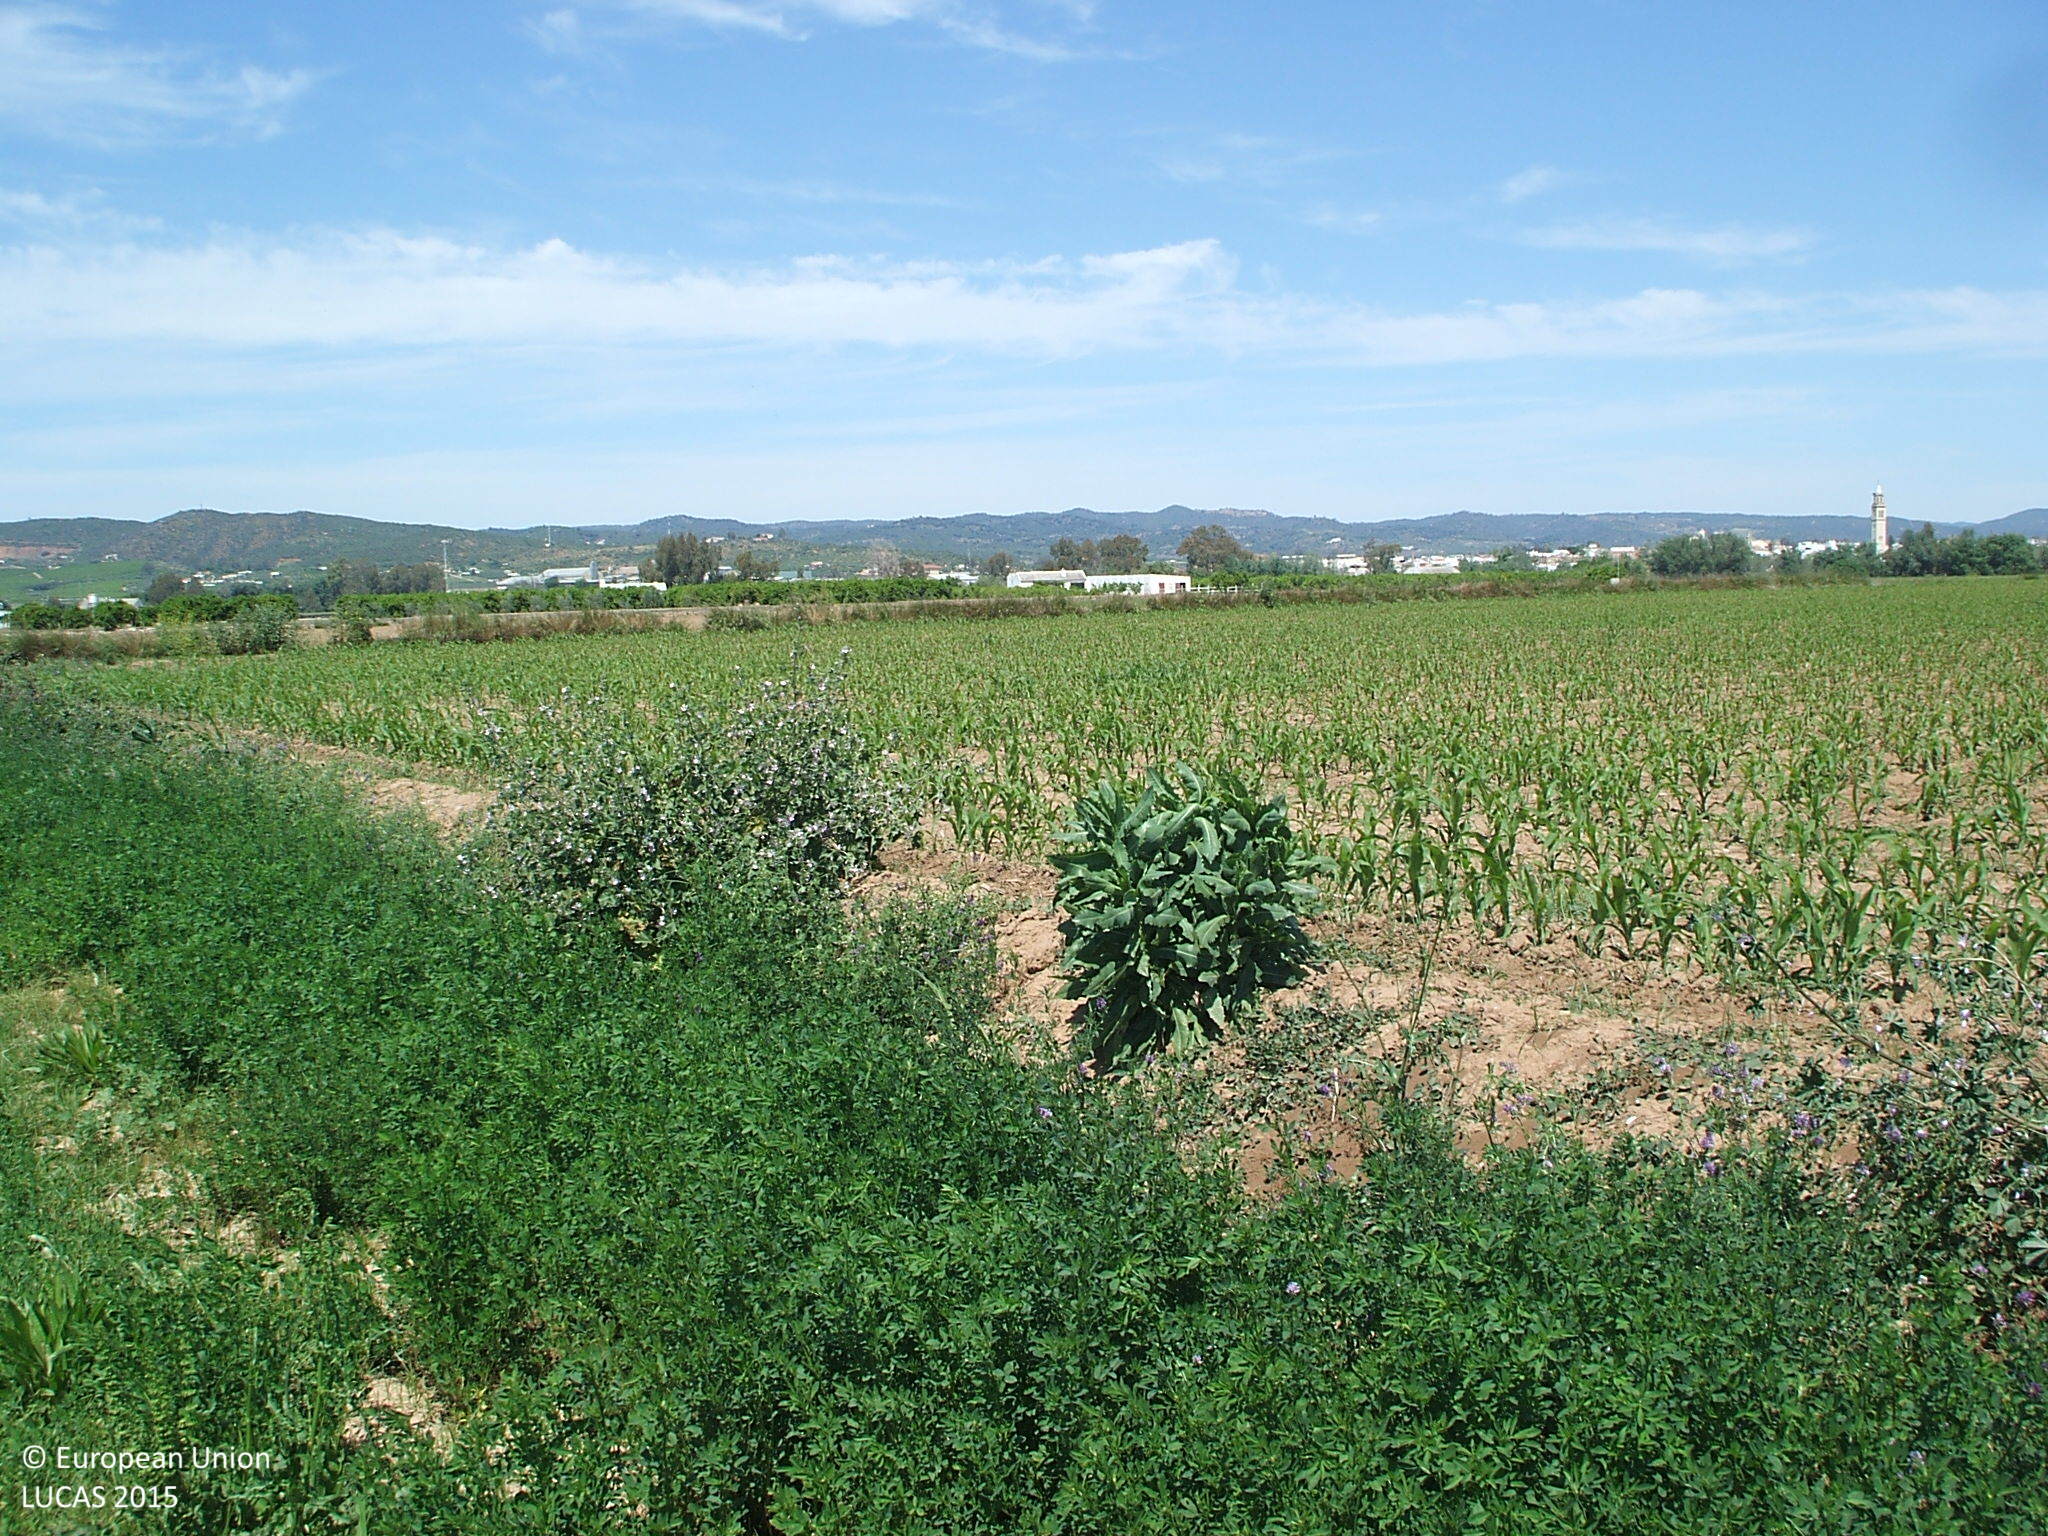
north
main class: Cropland
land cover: Maize
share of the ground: 50 - 75 %
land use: Agriculture (excluding fallow land and kitchen gardens)
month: April
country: ES
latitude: 37.6412
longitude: -5.5358
